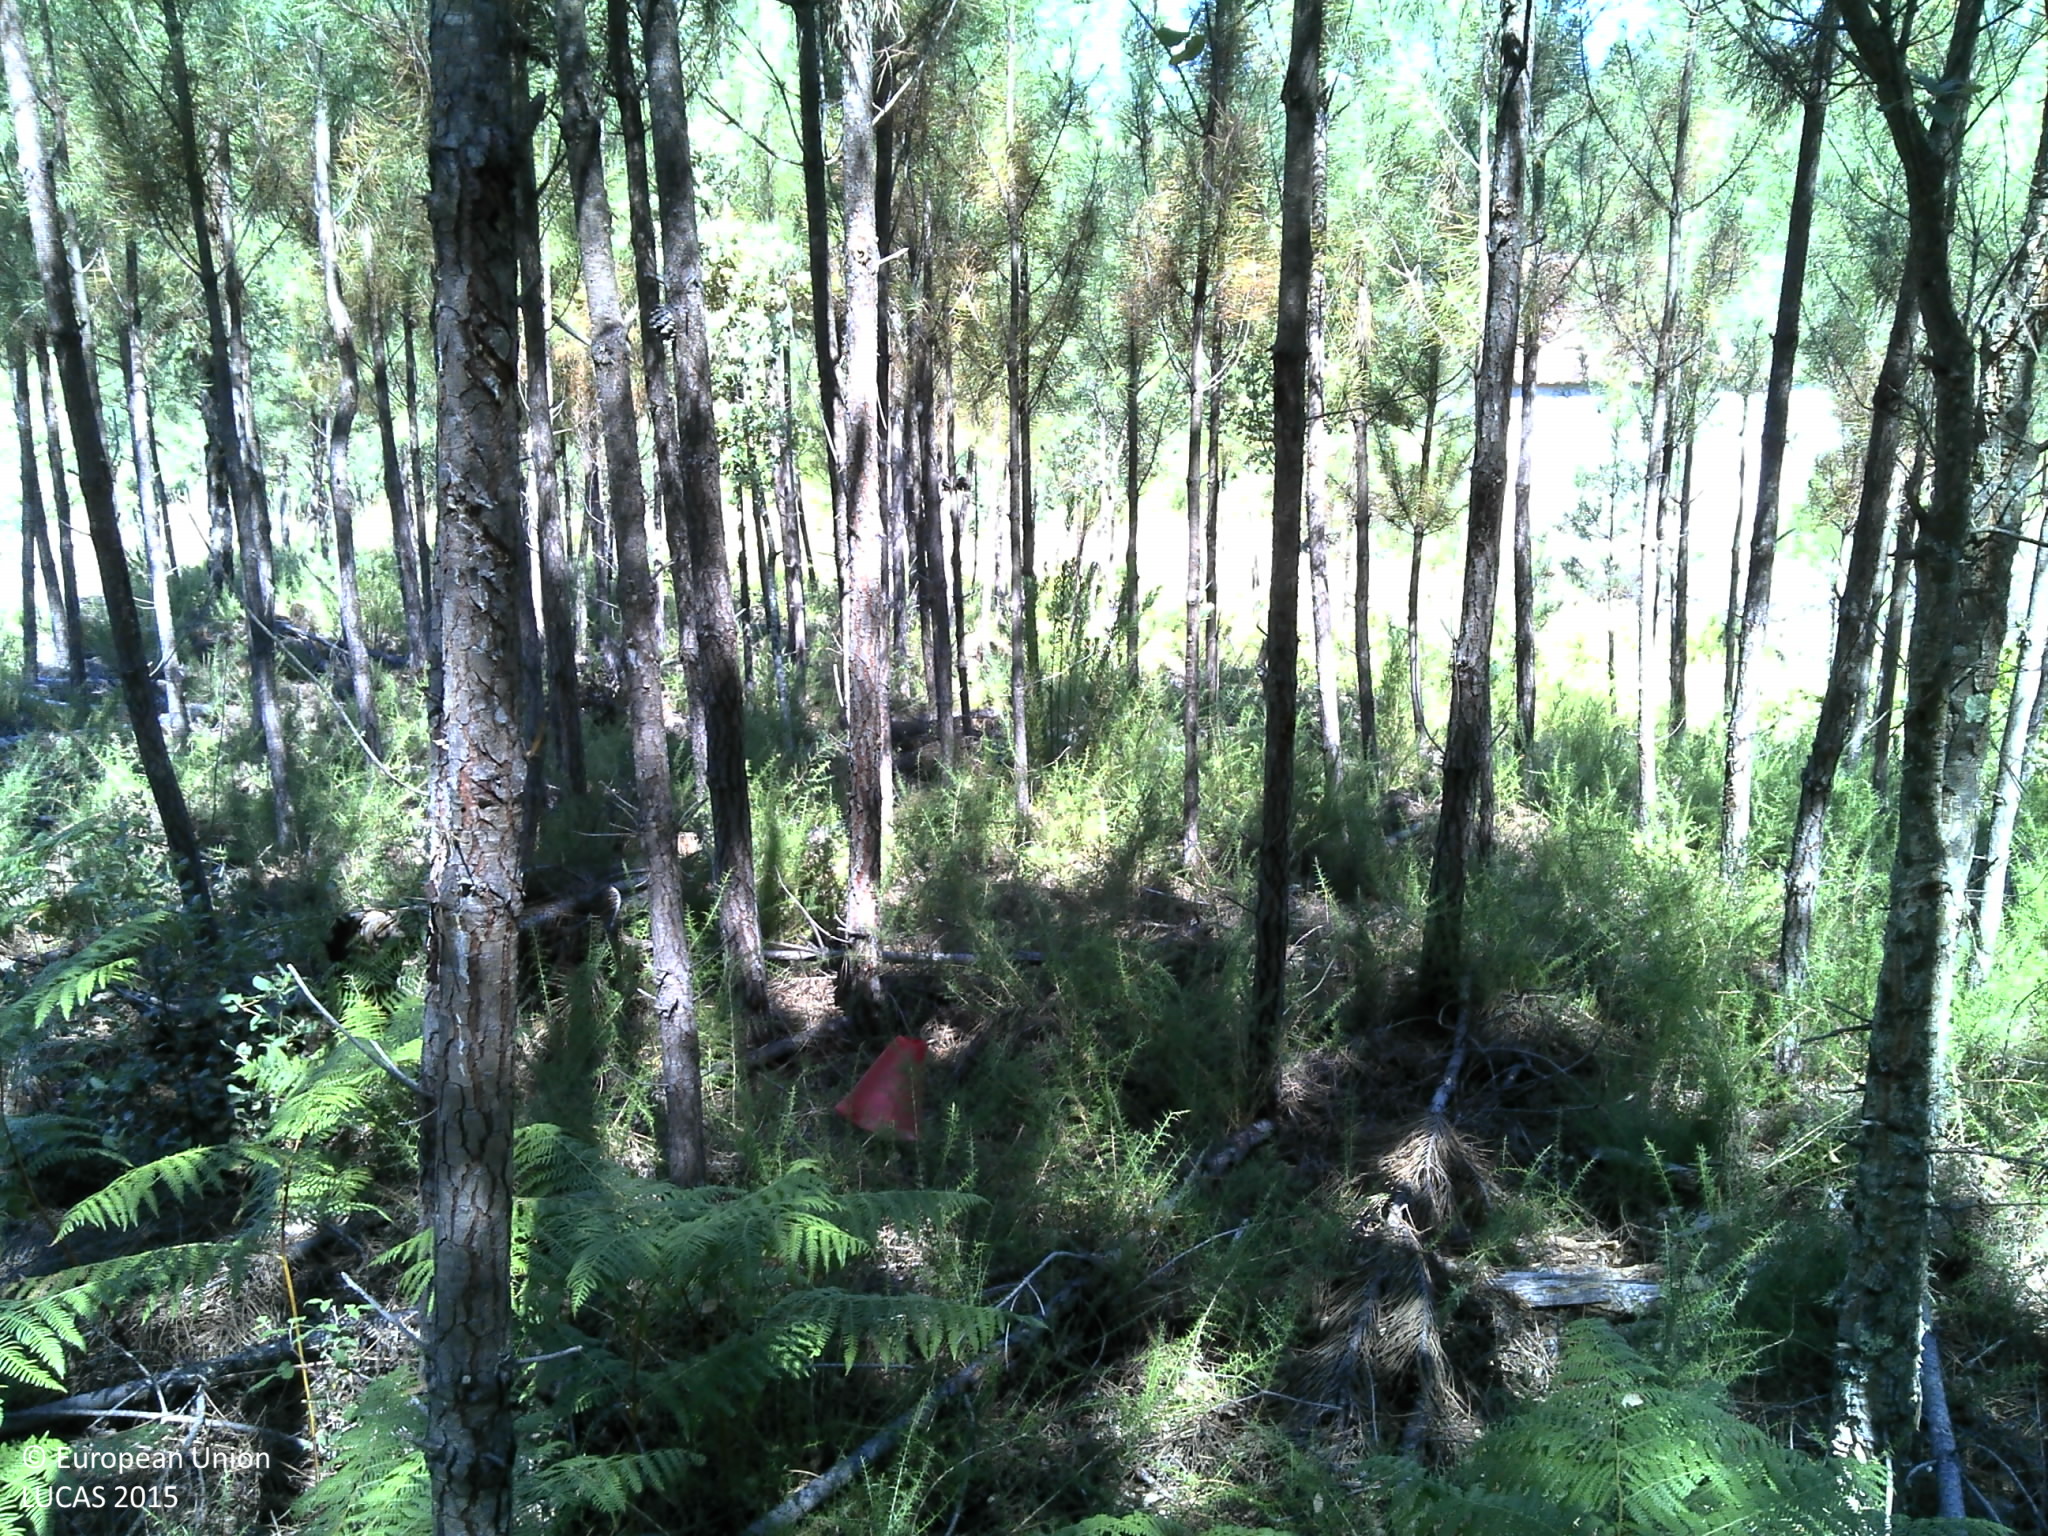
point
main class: Woodland
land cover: Pine dominated coniferous woodland
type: coniferous forest of the mediterranean region
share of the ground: 50 - 75 %
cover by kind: coniferous forest trees 50 %, shrubs 20 %, unconsolidated bare surface 10 %
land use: Forestry
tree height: > 5 m
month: July
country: PT
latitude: 39.7252
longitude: -8.1386
